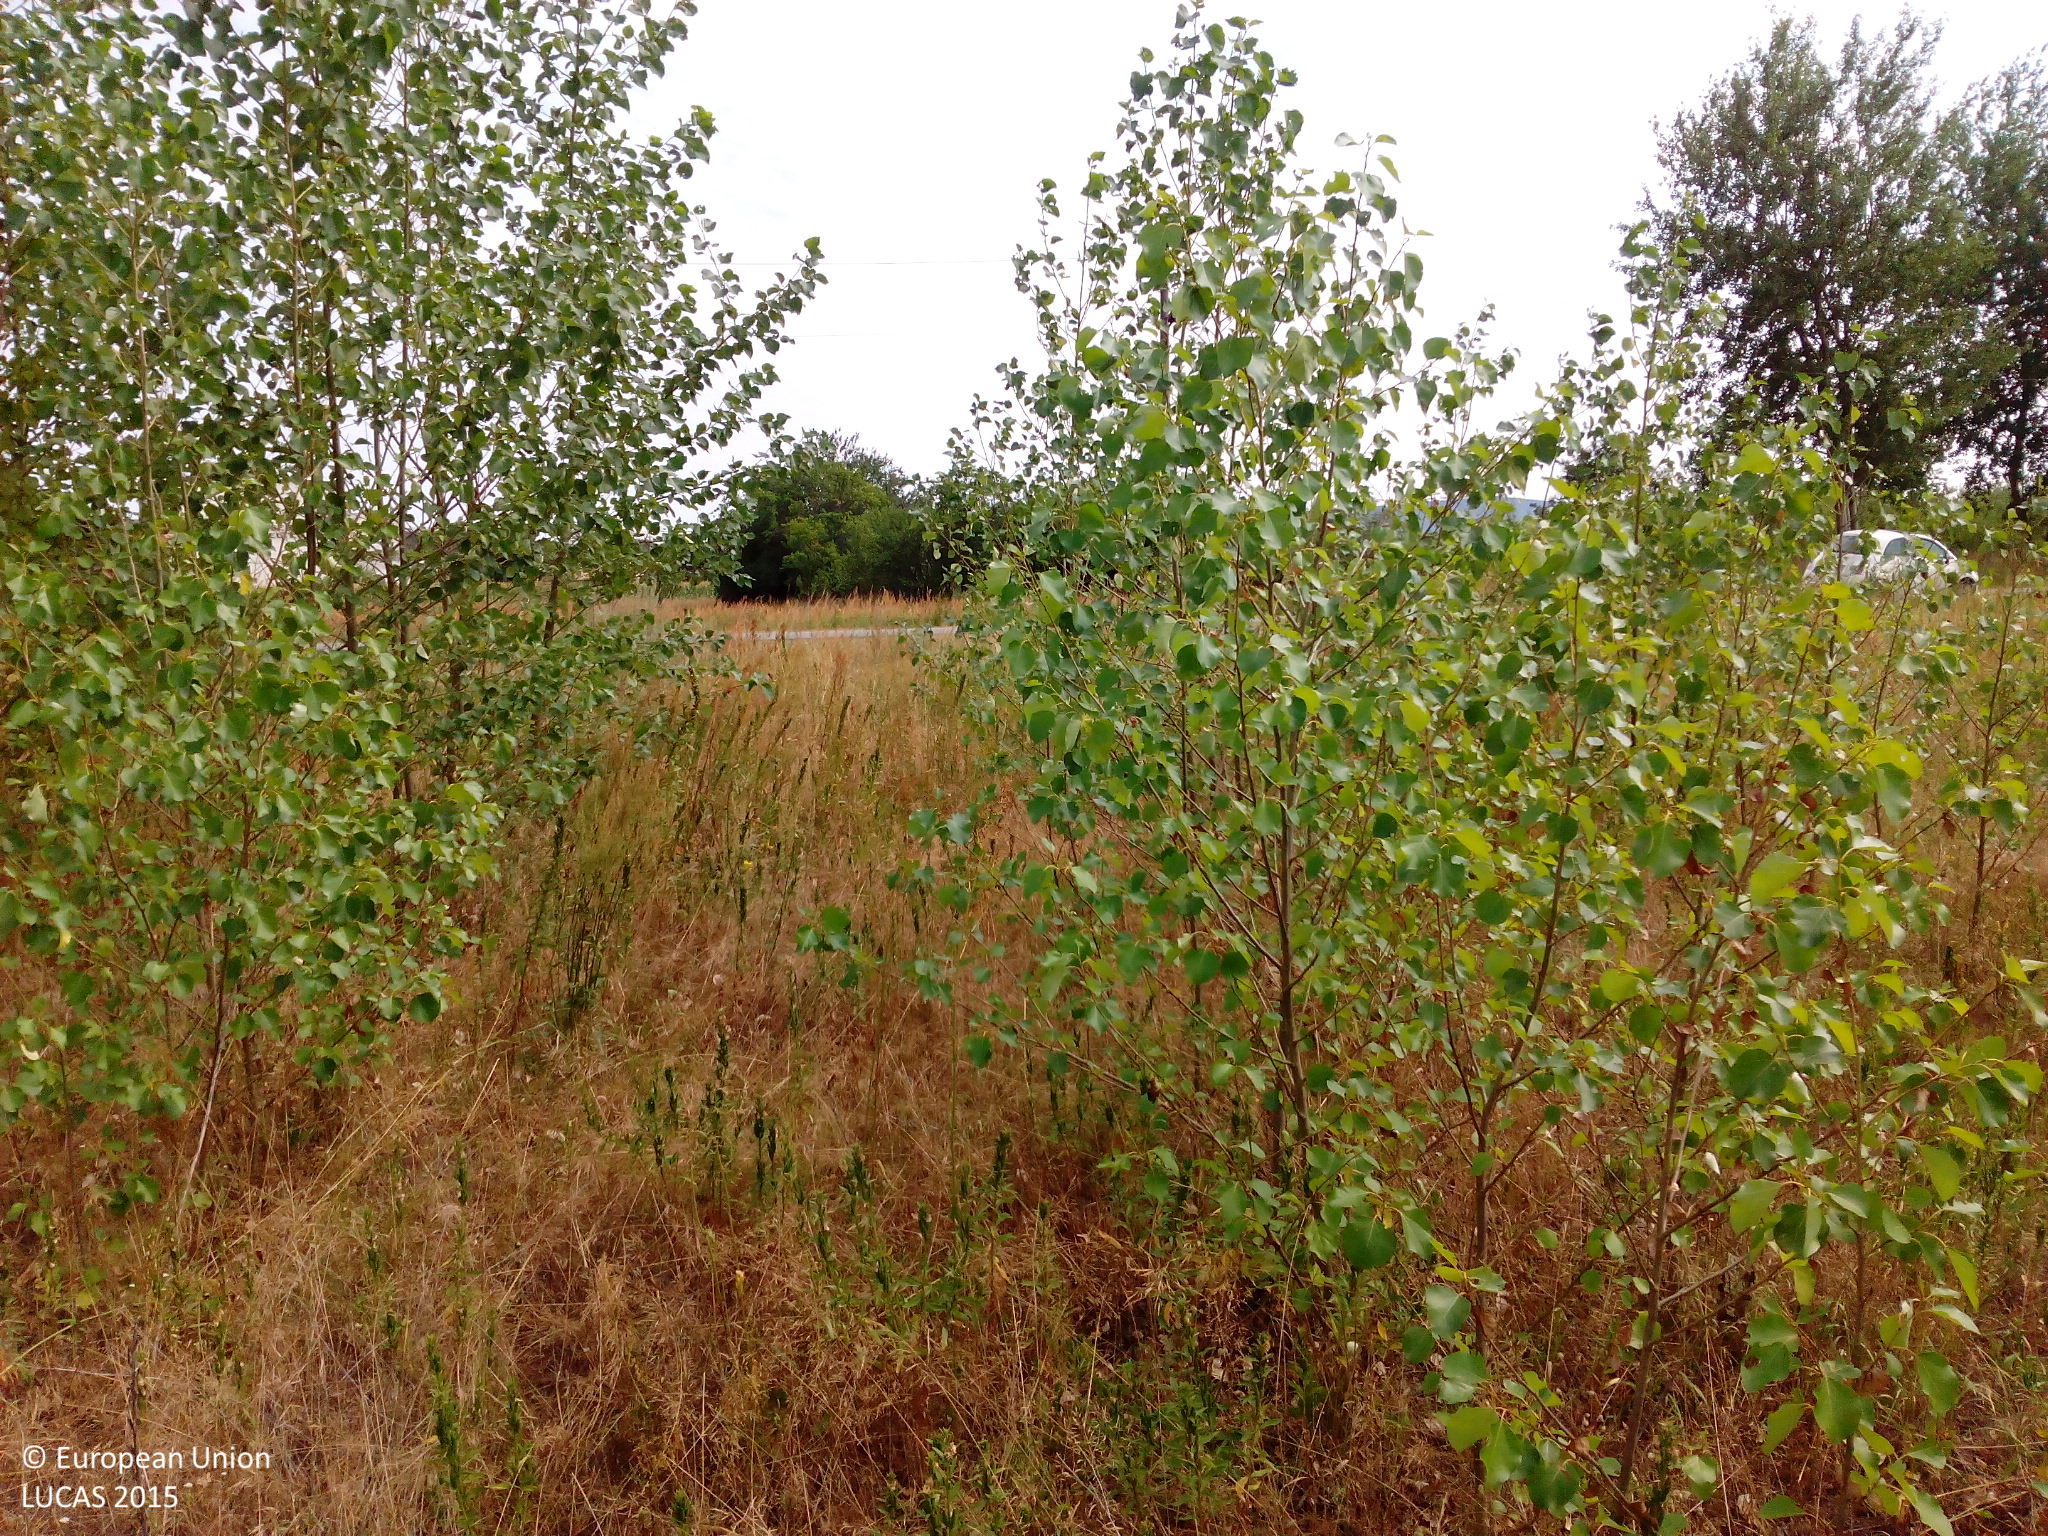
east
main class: Woodland
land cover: Broadleaved woodland
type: mesophytic deciduous forest
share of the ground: 25 - 50 %
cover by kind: broadleaved forest trees 50 %, herbaceous plants 50 %
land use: Semi-natural and natural areas not in use
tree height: < 5 m
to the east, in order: Broadleaved woodland; Spontaneously vegetated surfaces; Grass margins; Paved roads, cycling and walking lanes; Grass margins; Electric lines; Spontaneously vegetated surfaces; Broadleaved woodland; Spontaneously vegetated surfaces; Maize
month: August
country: DE
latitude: 52.6767
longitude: 13.1798
